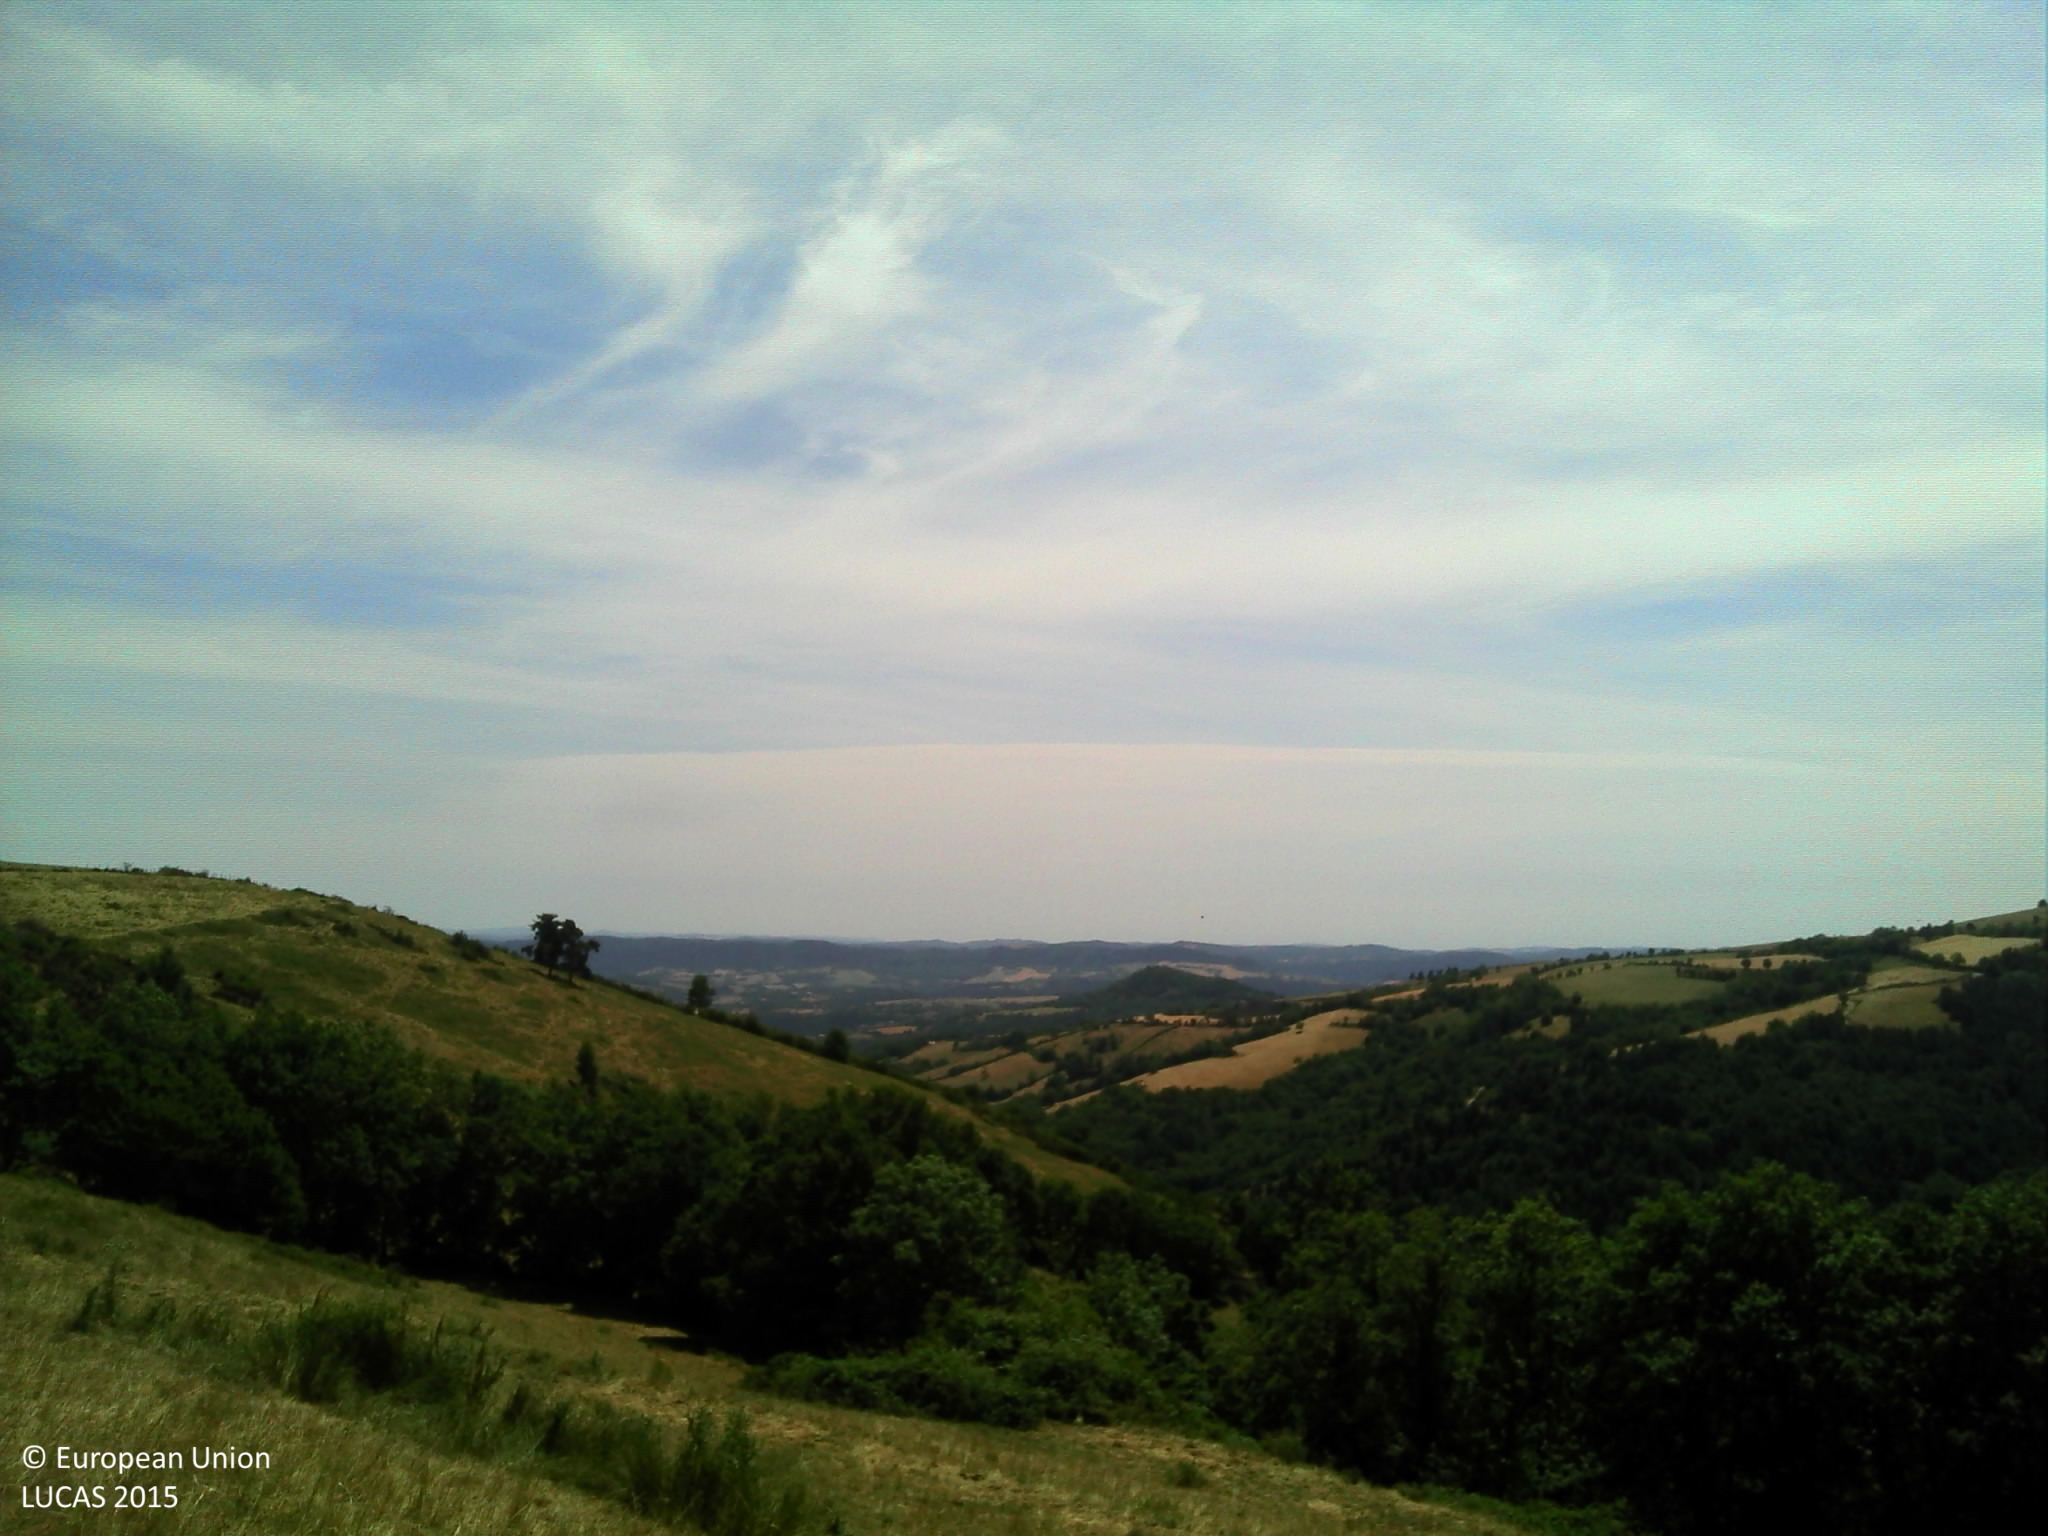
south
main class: Grassland
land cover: Grassland without tree/shrub cover
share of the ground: > 75 %
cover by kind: herbaceous plants 95 %, shrubs 5 %
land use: Agriculture (excluding fallow land and kitchen gardens)
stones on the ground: 25 - 50 %
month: July
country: FR
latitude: 44.5644
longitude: 3.2432
